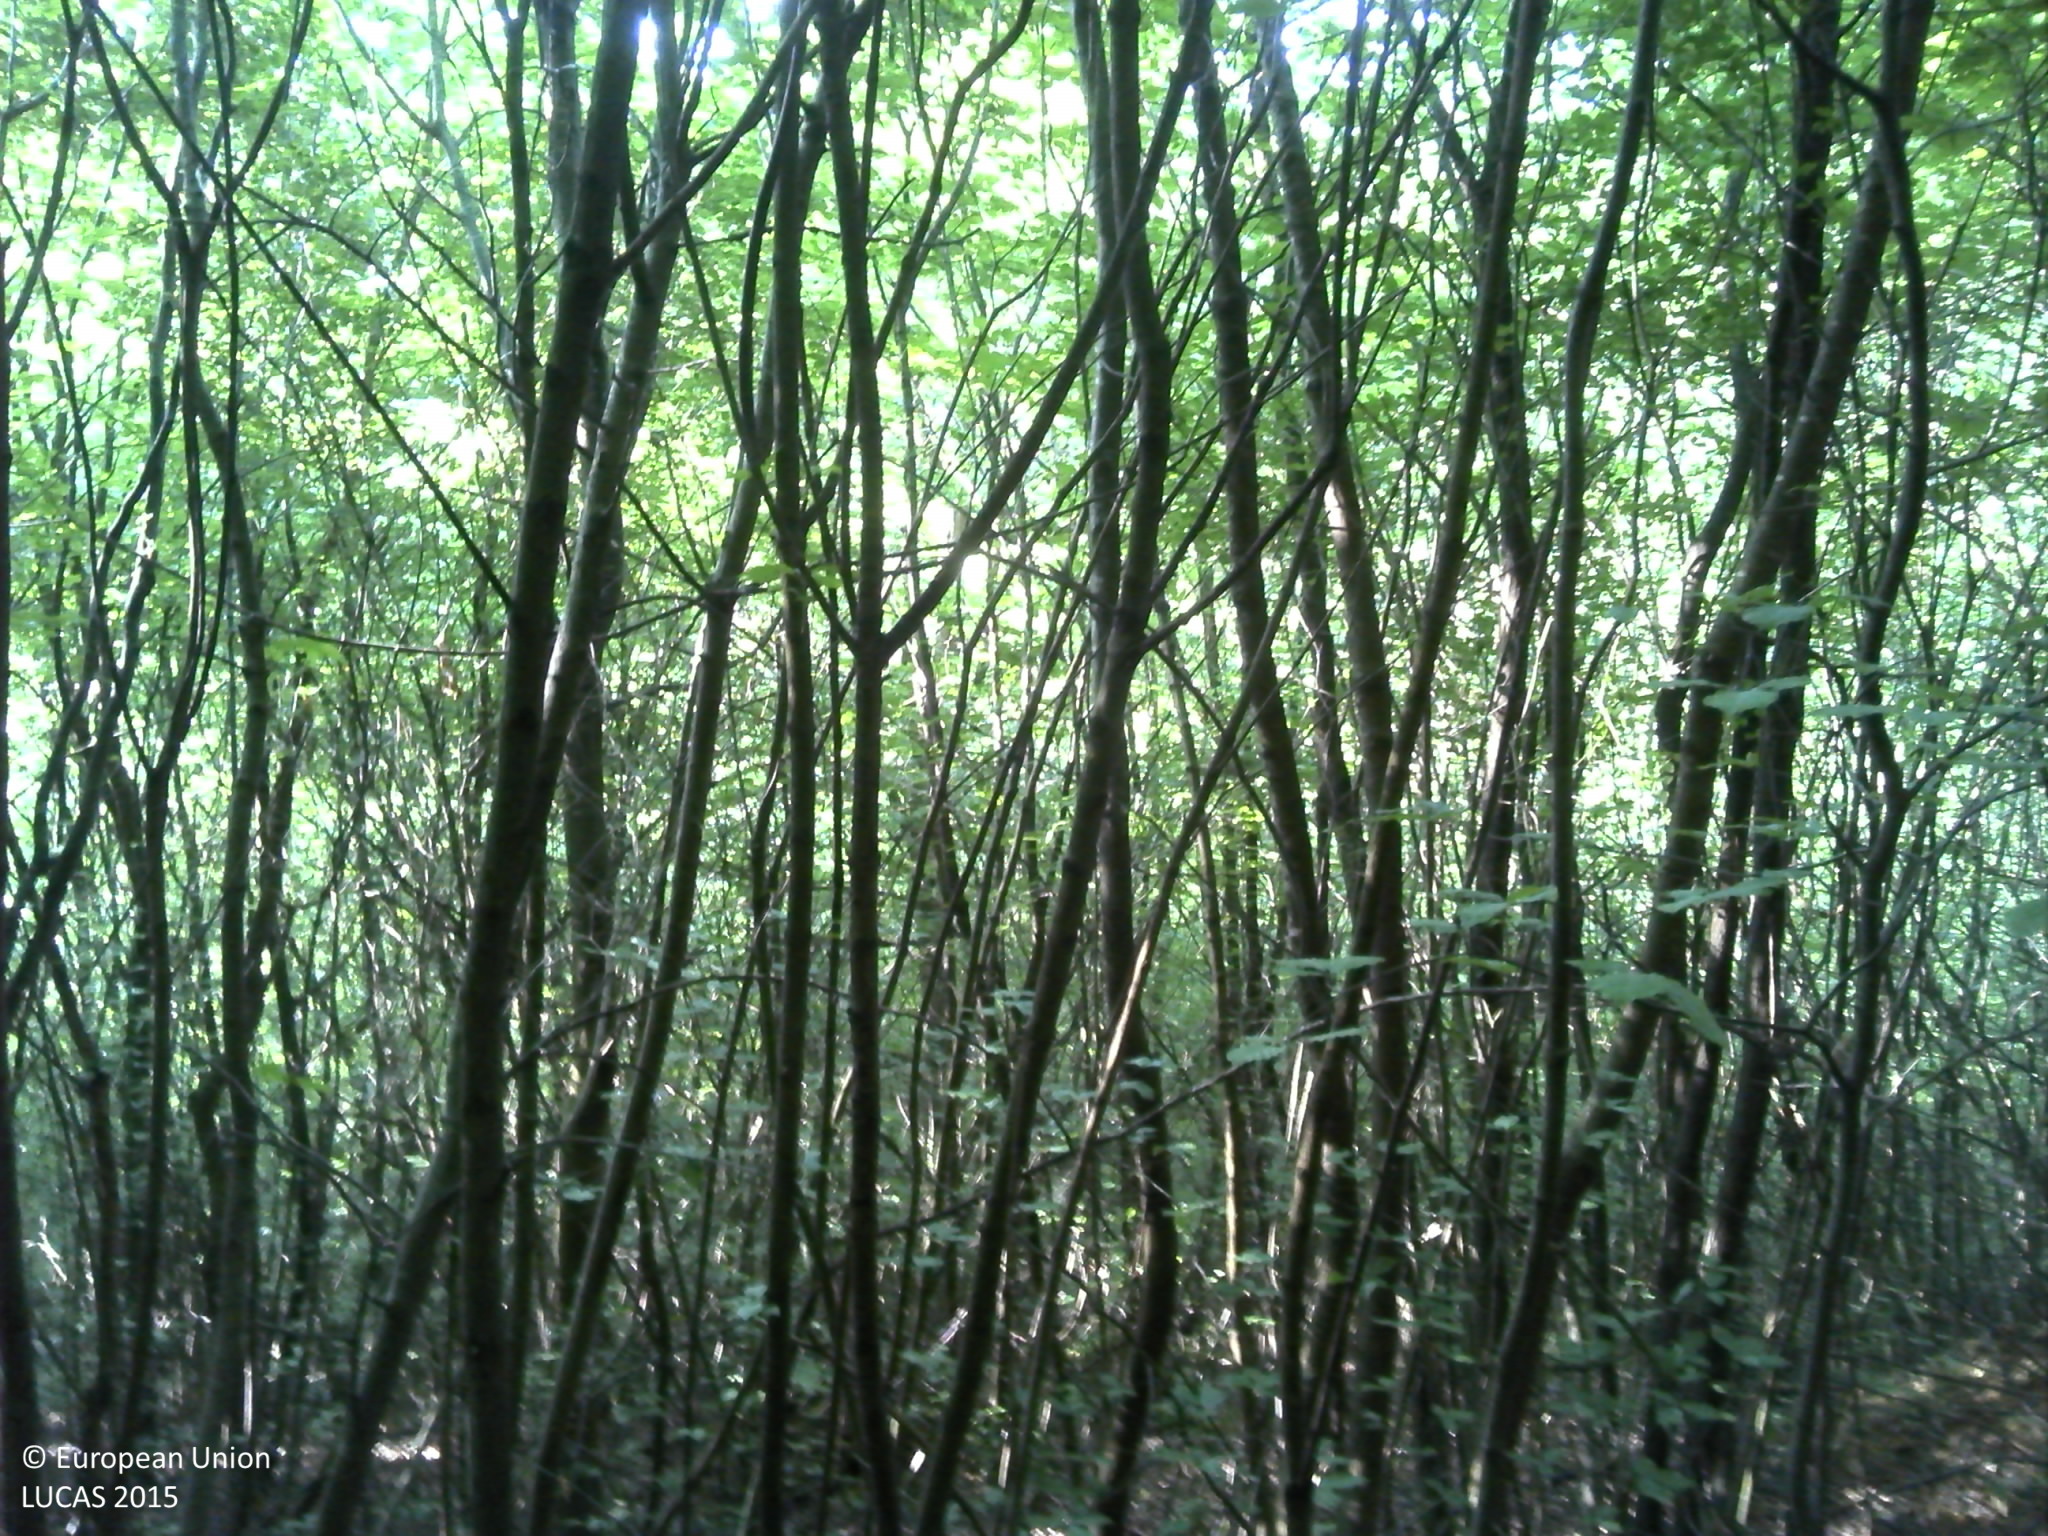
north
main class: Woodland
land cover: Broadleaved woodland
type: beech forest
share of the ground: > 75 %
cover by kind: broadleaved forest trees 100 %
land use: Forestry
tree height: > 5 m
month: June
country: FR
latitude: 49.2168
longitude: 6.0869
